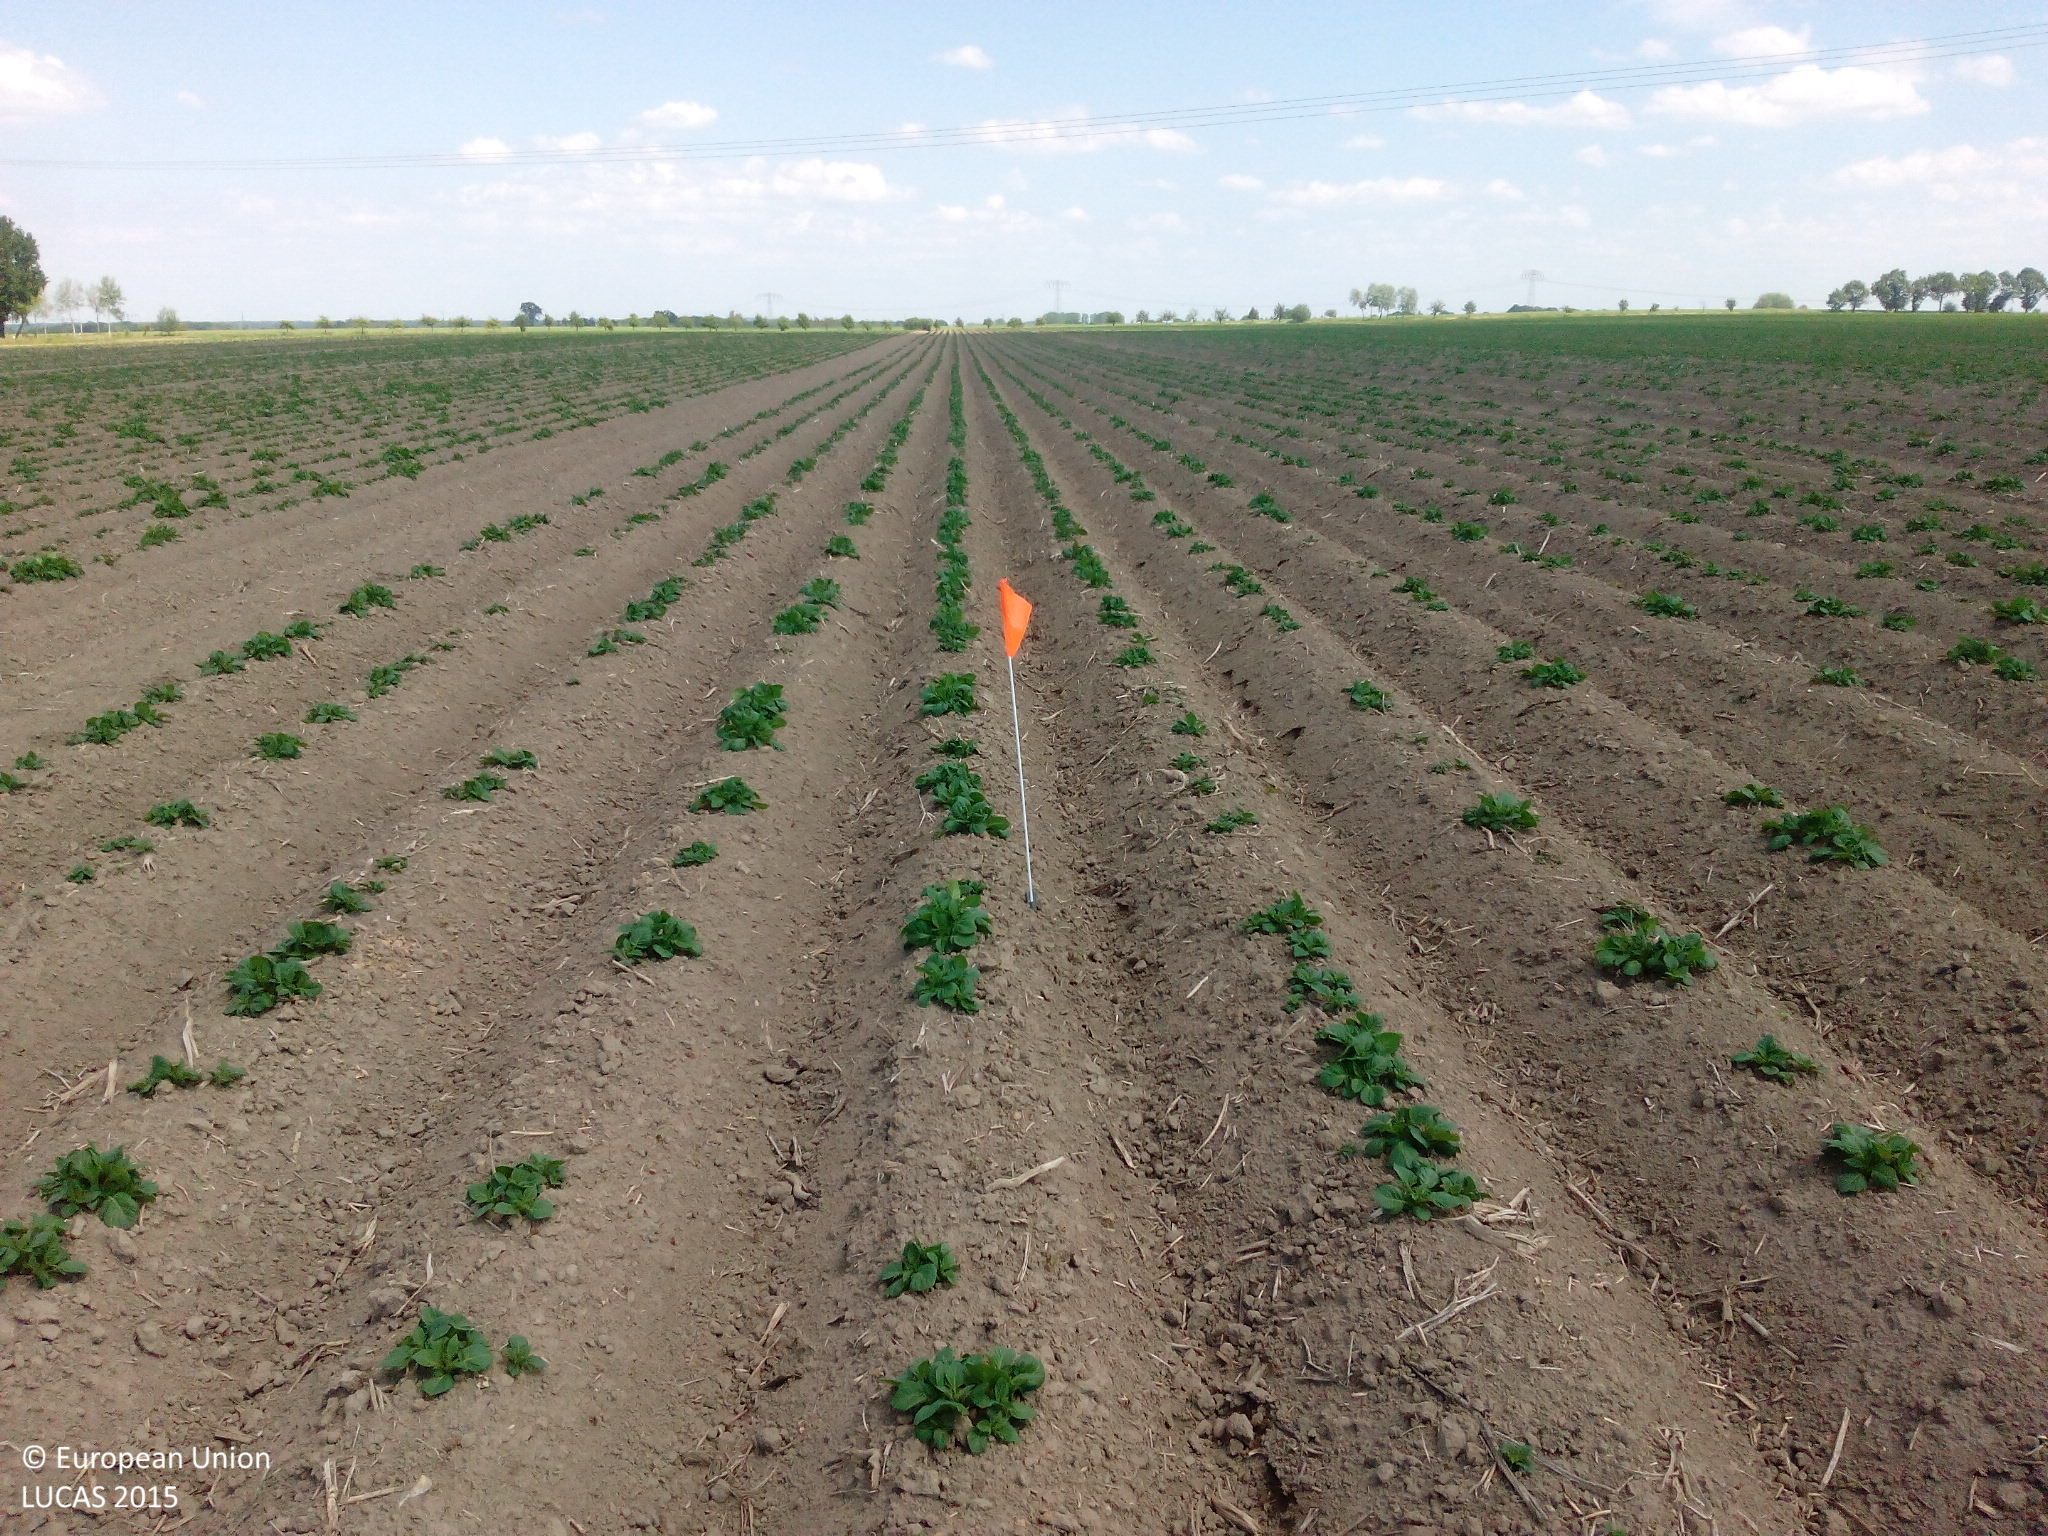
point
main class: Cropland
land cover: Potatoes
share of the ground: < 10 %
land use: Agriculture (excluding fallow land and kitchen gardens)
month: June
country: DE
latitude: 51.1815
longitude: 12.5319
